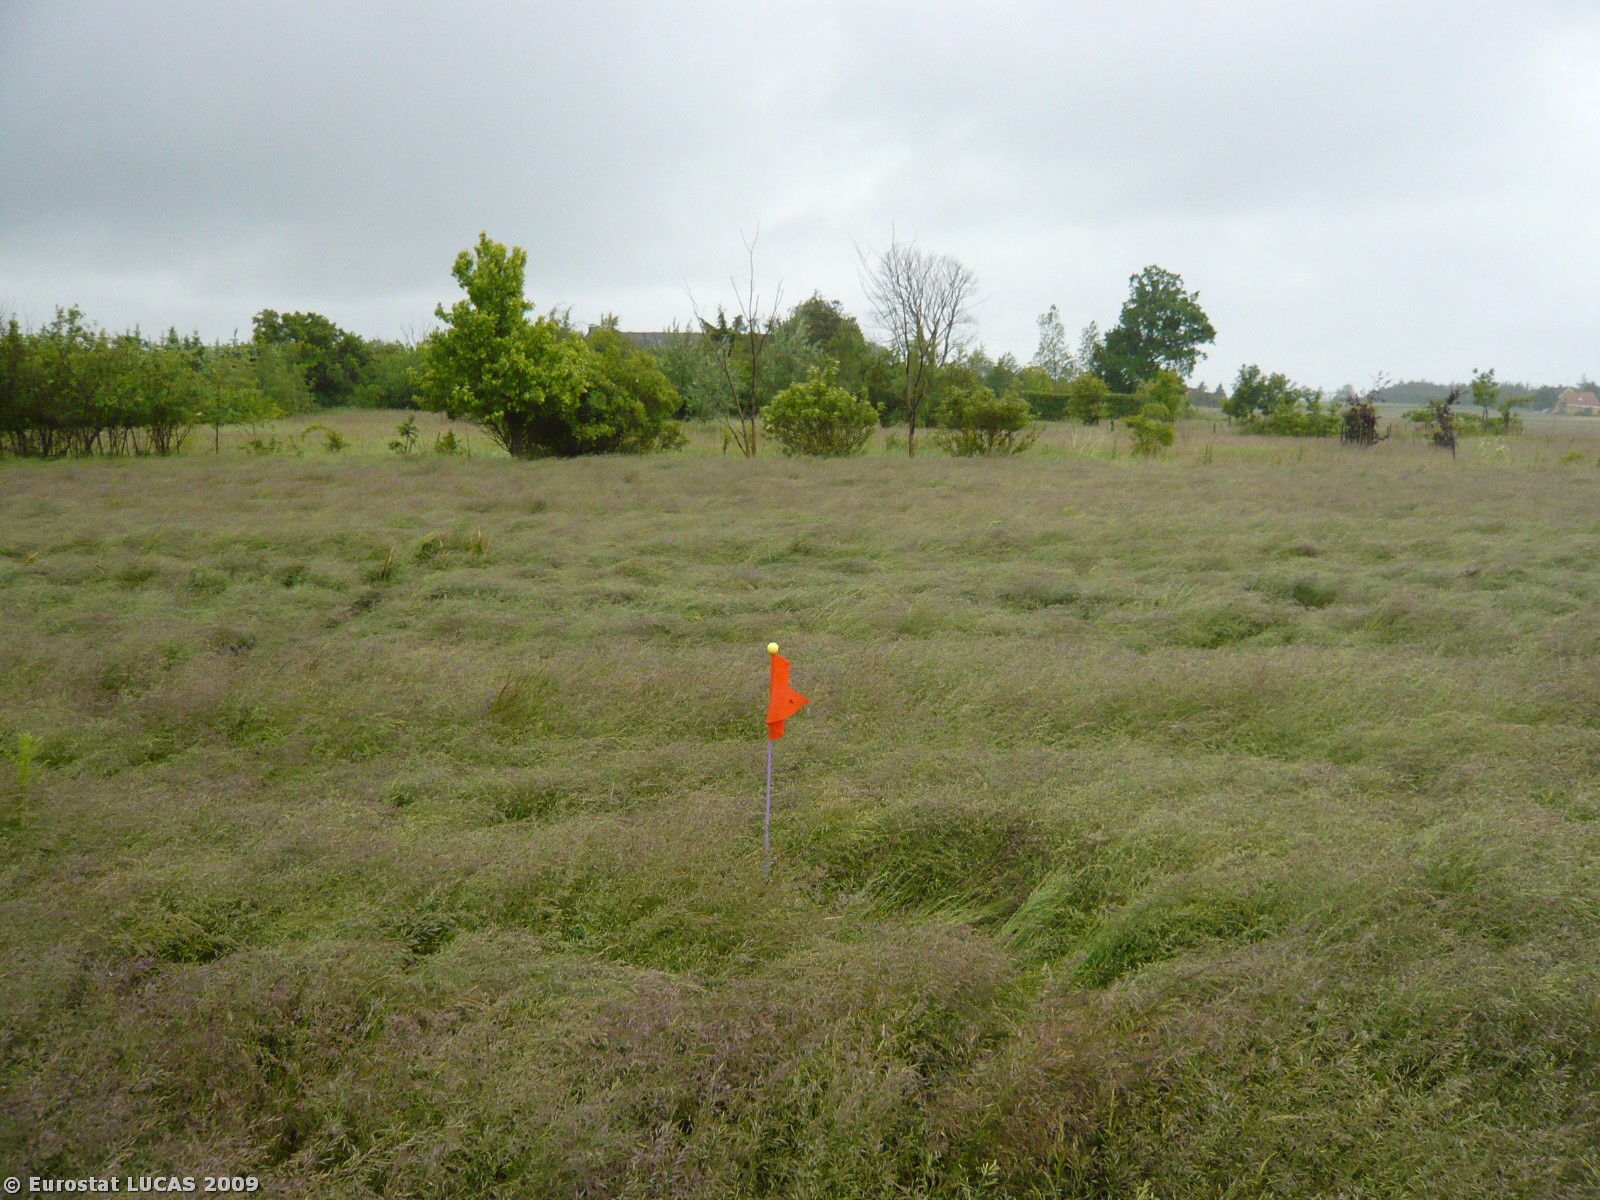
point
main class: Cropland
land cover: Temporary grasslands
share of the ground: > 75 %
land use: Agriculture (excluding fallow land and kitchen gardens)
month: June
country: DK
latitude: 54.6638
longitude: 11.8748
